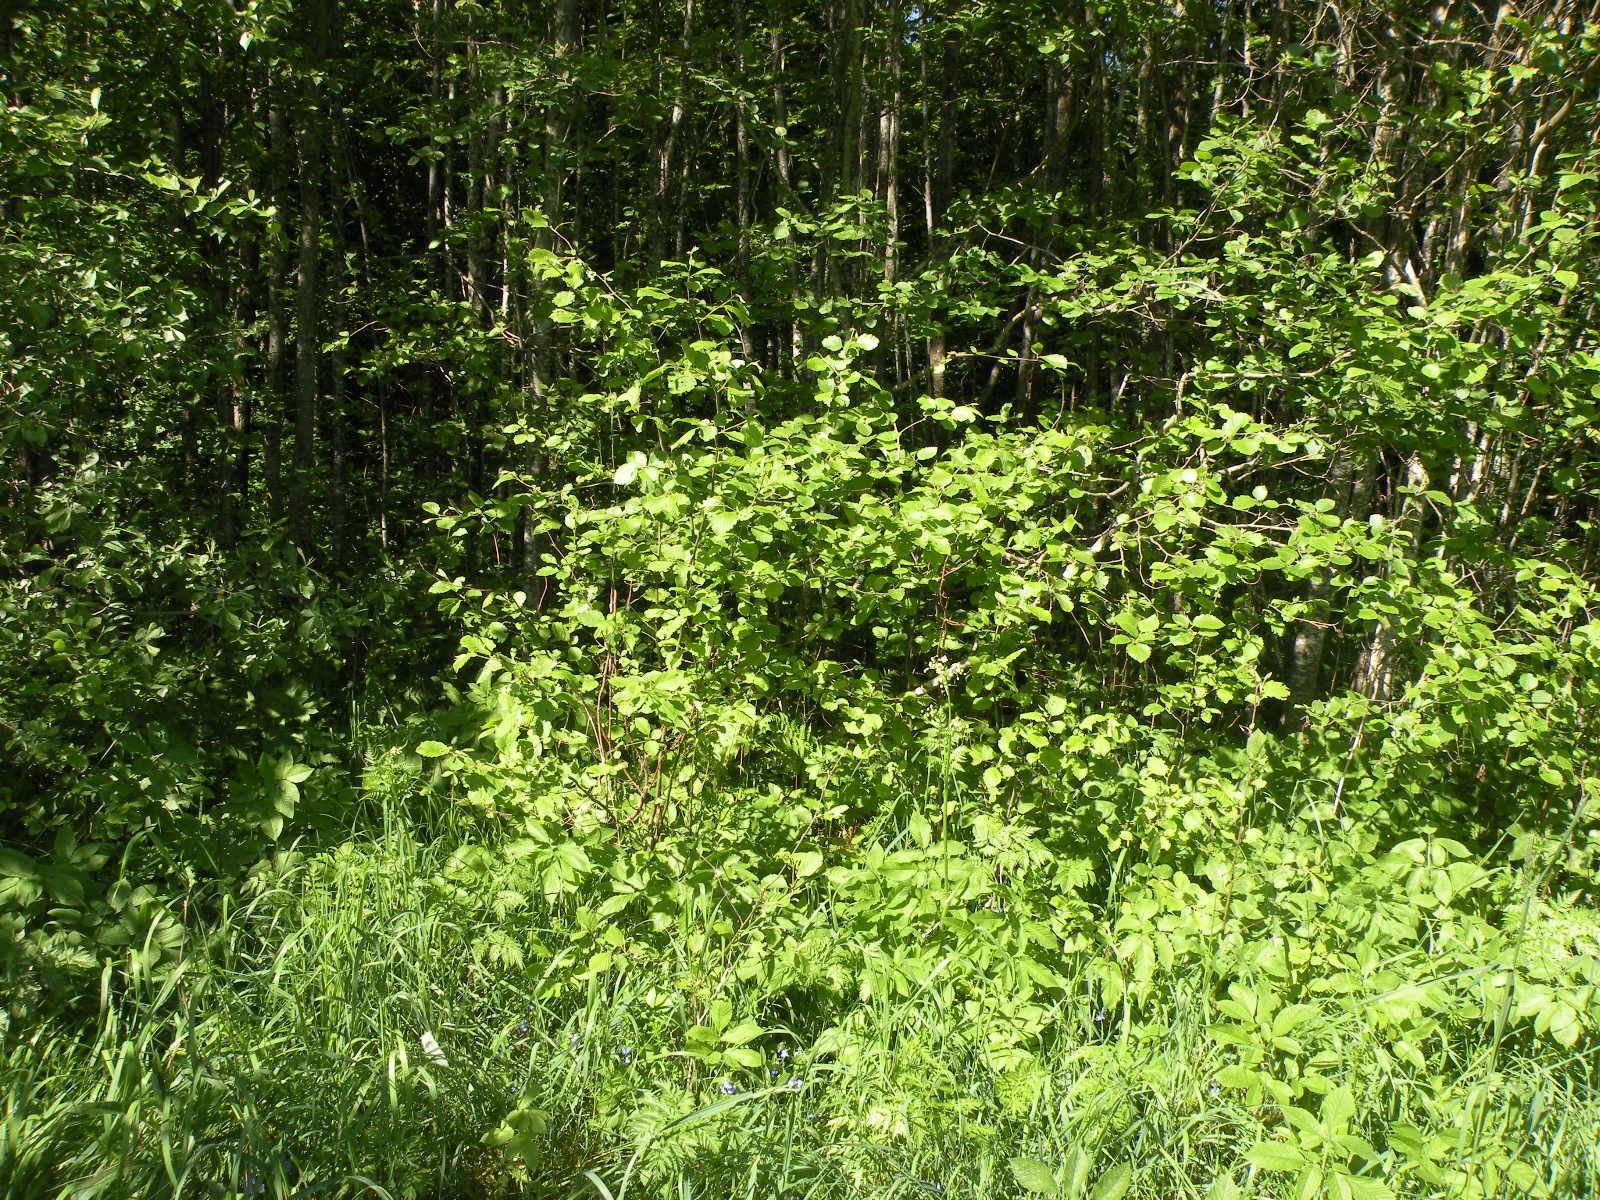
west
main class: Grassland
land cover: Grassland without tree/shrub cover
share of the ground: > 75 %
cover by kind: herbaceous plants 100 %
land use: Agriculture (excluding fallow land and kitchen gardens)
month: May
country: LV
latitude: 56.0259
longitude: 26.2360
